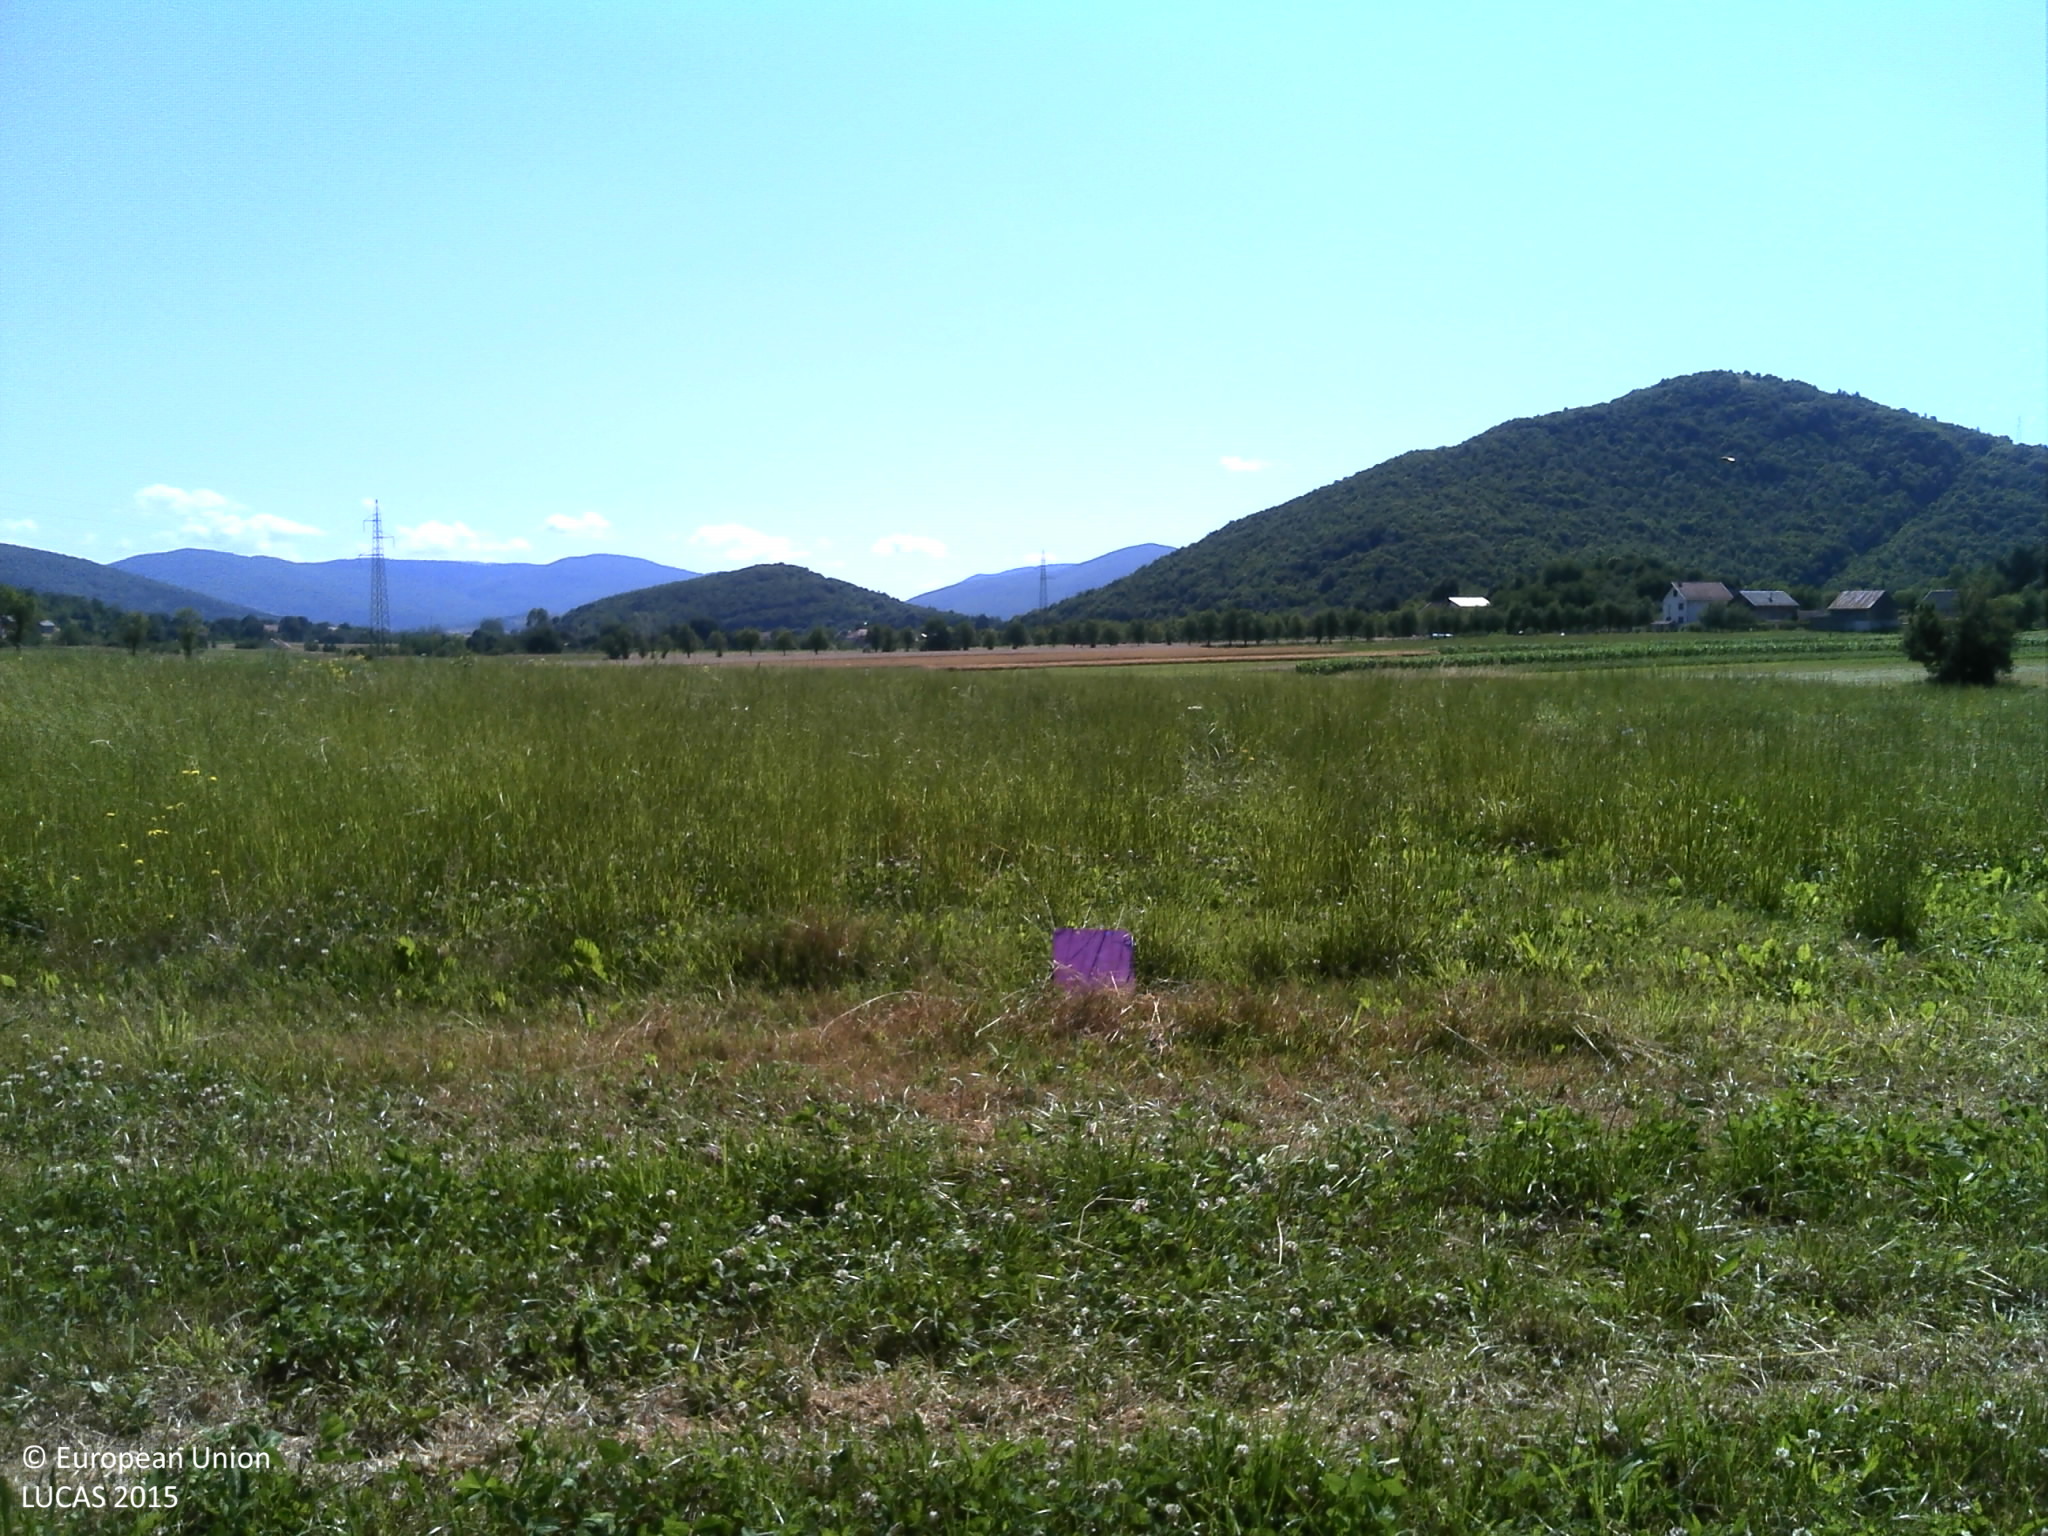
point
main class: Grassland
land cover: Grassland without tree/shrub cover
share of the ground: > 75 %
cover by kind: herbaceous plants 100 %
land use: Agriculture (excluding fallow land and kitchen gardens)
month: July
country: HR
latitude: 44.8503
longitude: 15.2451
